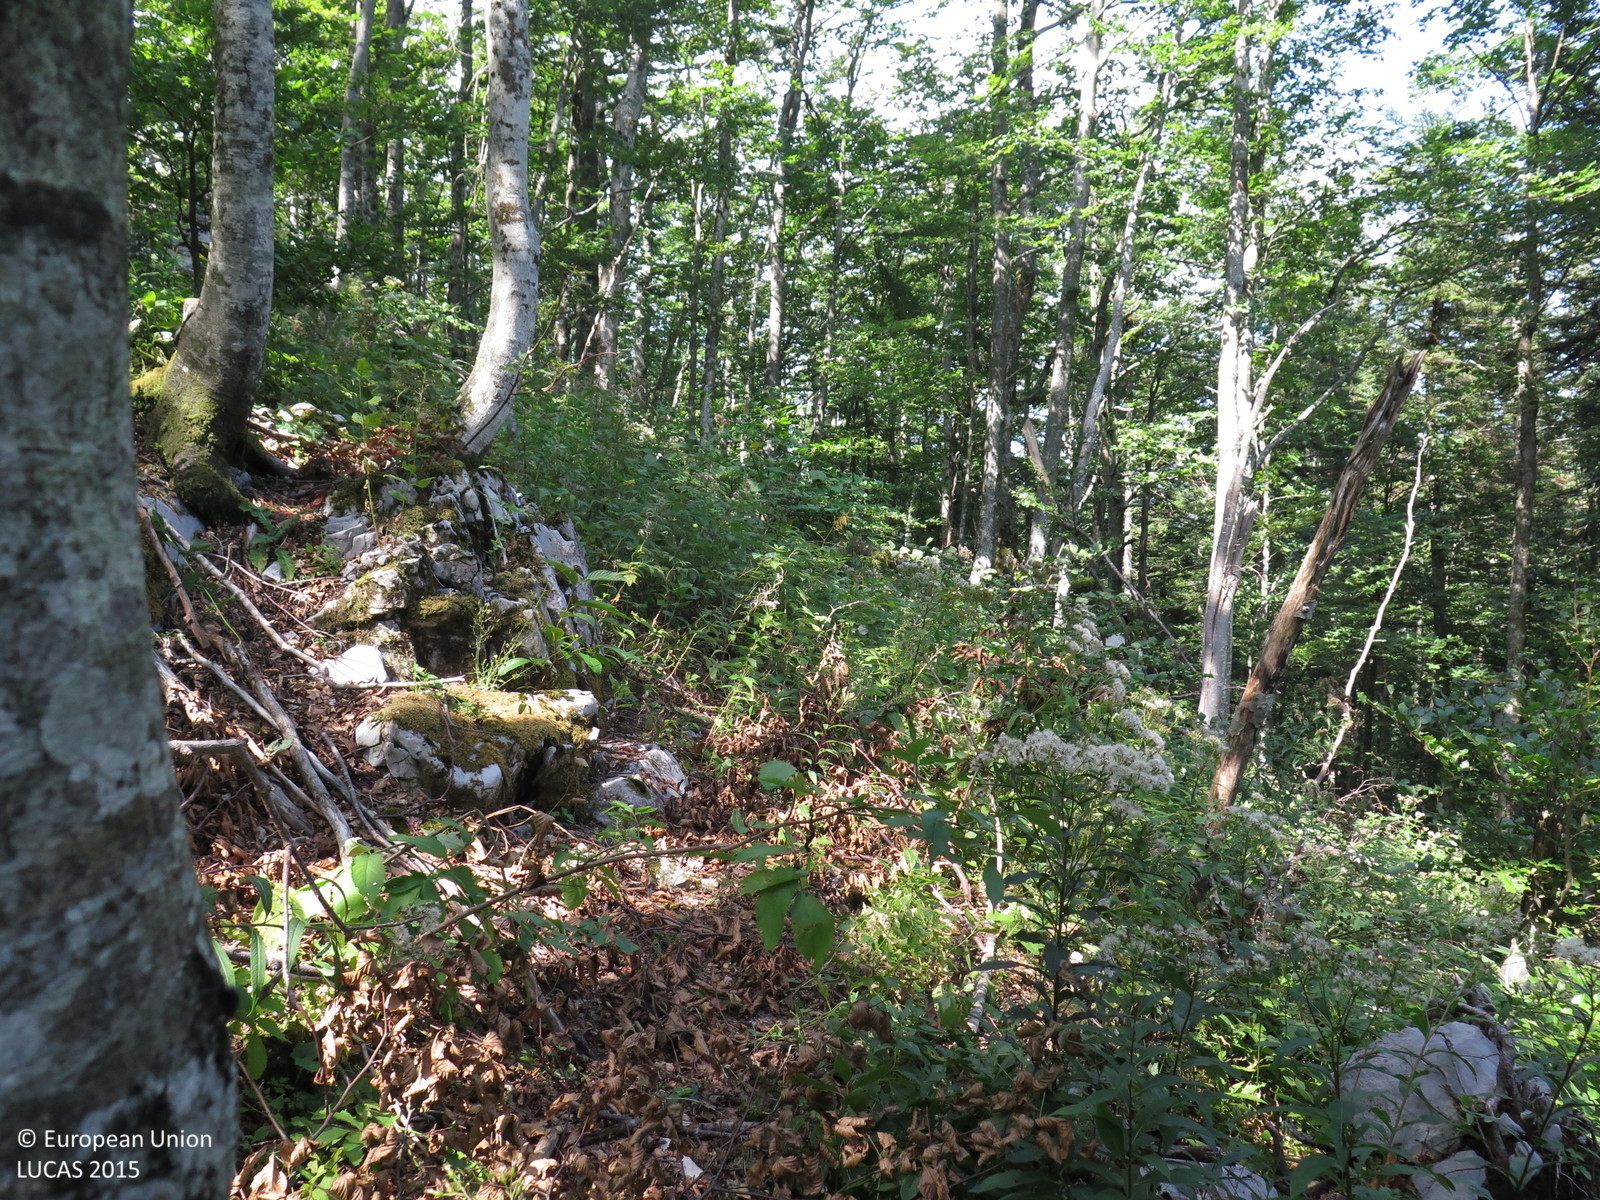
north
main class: Woodland
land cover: Broadleaved woodland
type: mountainous beech forest
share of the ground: > 75 %
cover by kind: broadleaved forest trees 75 %, coniferous forest trees 25 %
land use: Forestry
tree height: > 5 m
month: August
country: HR
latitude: 45.1707
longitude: 14.9698
